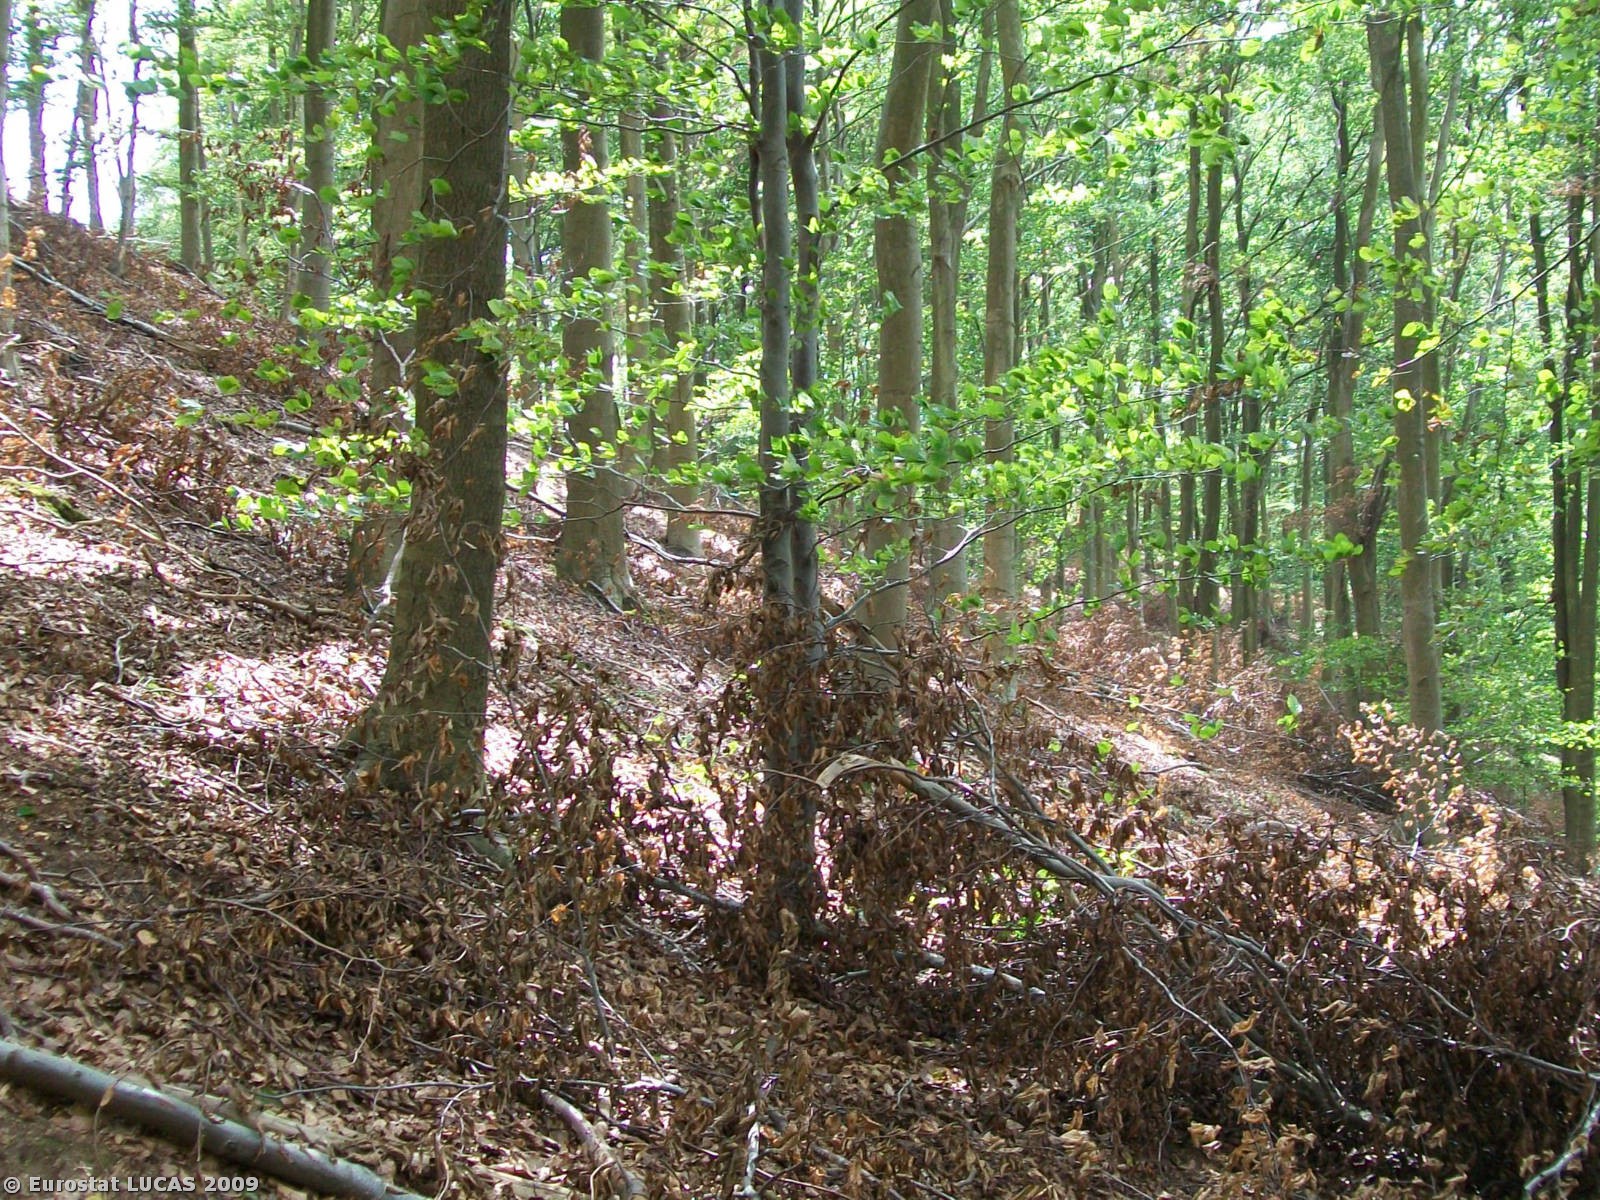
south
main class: Woodland
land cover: Broadleaved woodland
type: mesophytic deciduous forest
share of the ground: > 75 %
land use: Forestry
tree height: > 5 m
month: August
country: GB
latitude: 51.9794
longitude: -2.3963
